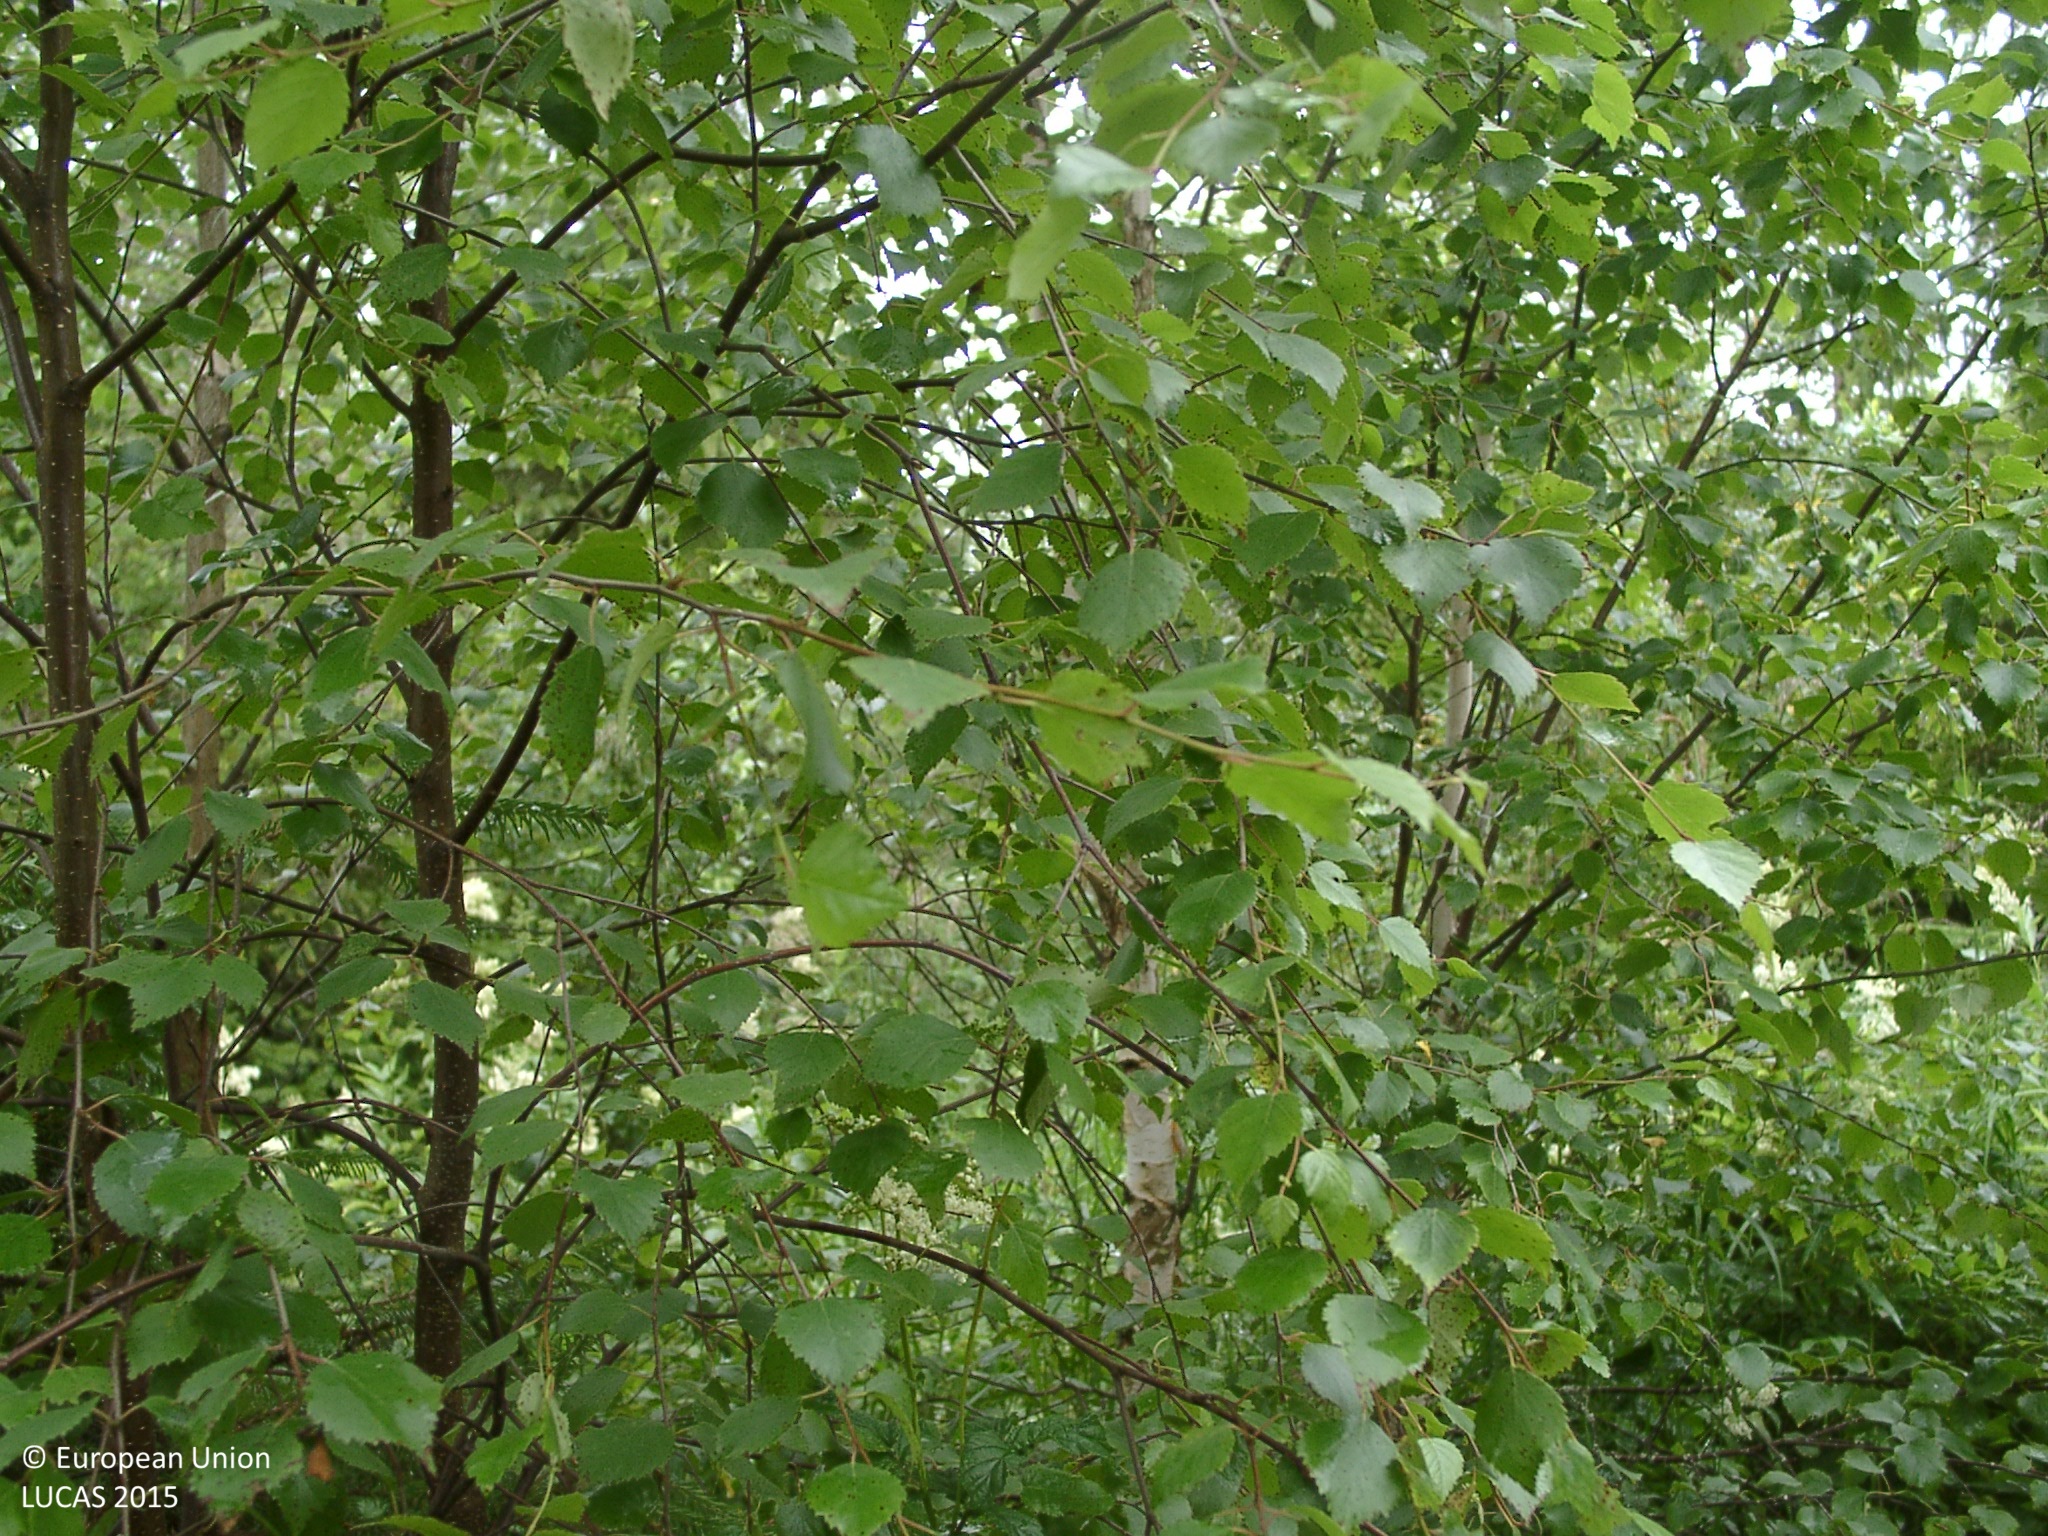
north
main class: Woodland
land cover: Spruce dominated mixed woodland
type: boreal forest
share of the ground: 50 - 75 %
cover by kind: coniferous forest trees 30 %, broadleaved forest trees 25 %, herbaceous plants 25 %, shrubs 20 %
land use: Forestry
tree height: < 5 m
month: July
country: FI
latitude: 62.2495
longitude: 25.4565
